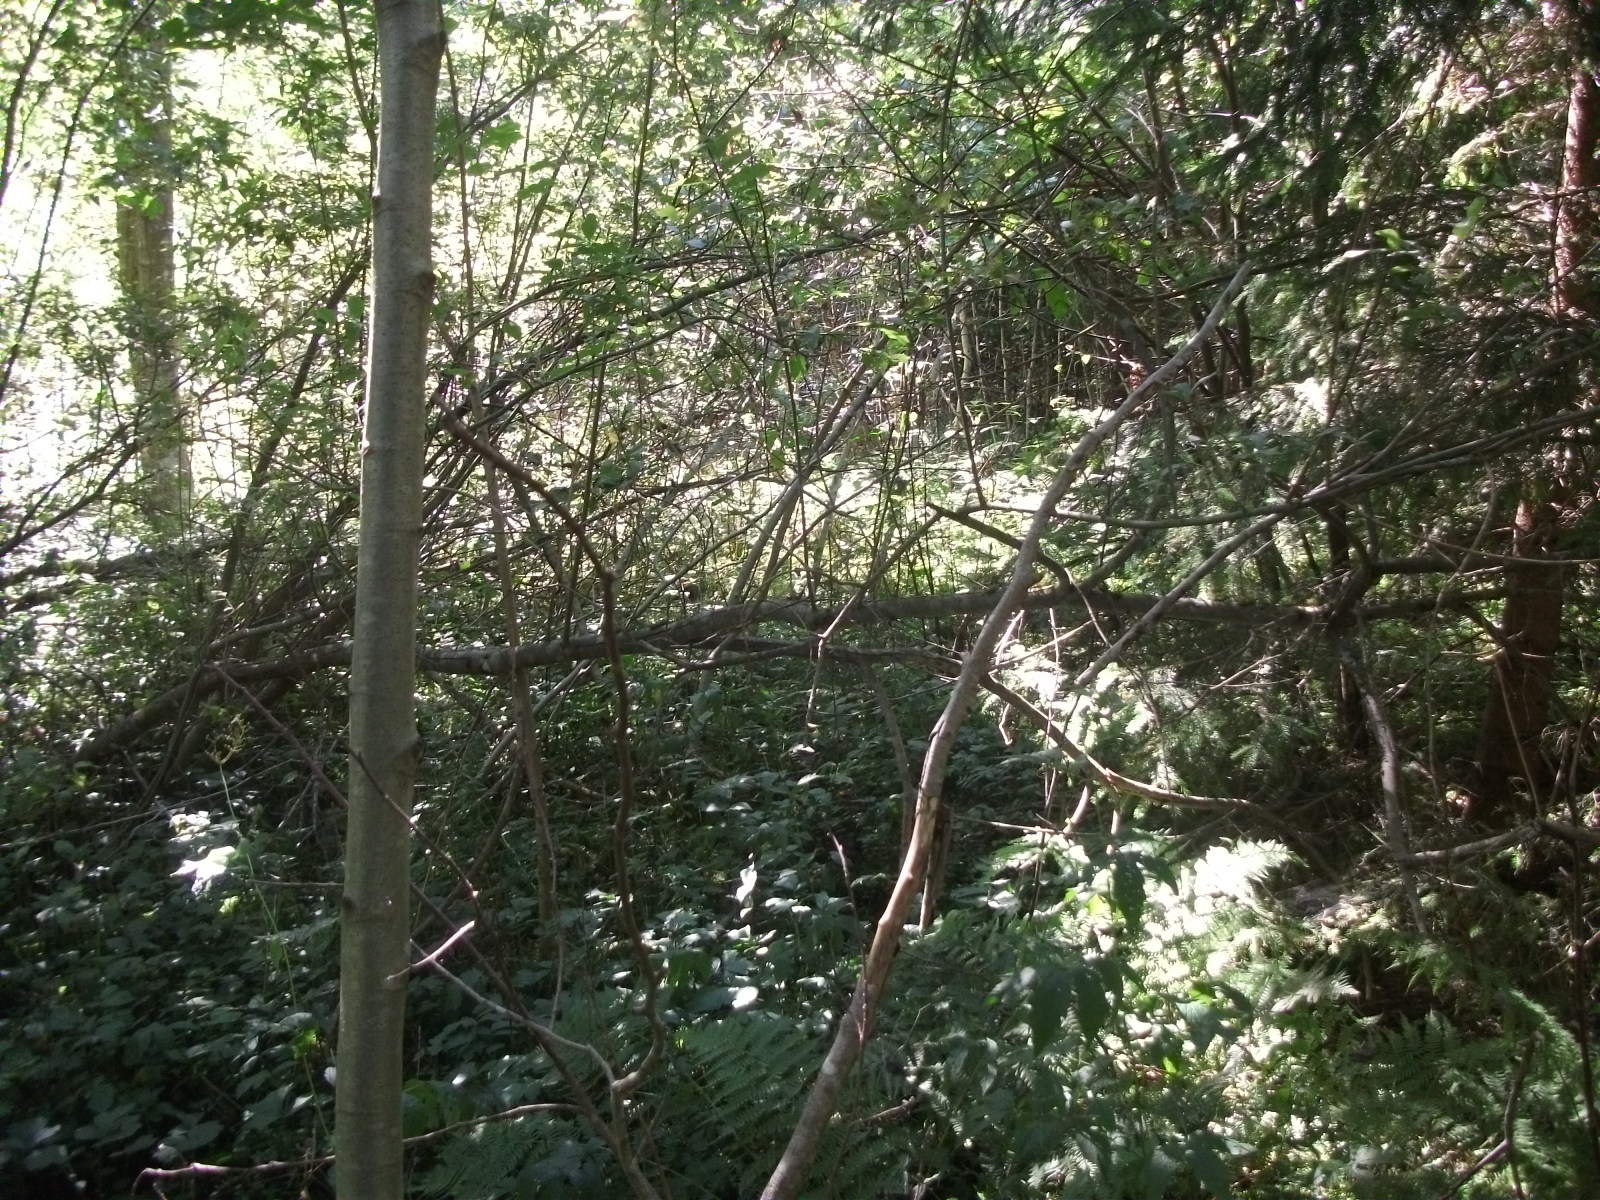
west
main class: Woodland
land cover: Broadleaved woodland
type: non-riverine alder, birch or aspen forest
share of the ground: > 75 %
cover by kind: broadleaved forest trees 85 %, herbaceous plants 10 %, shrubs 5 %
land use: Forestry
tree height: > 5 m
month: August
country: LV
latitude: 56.6324
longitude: 26.0954
